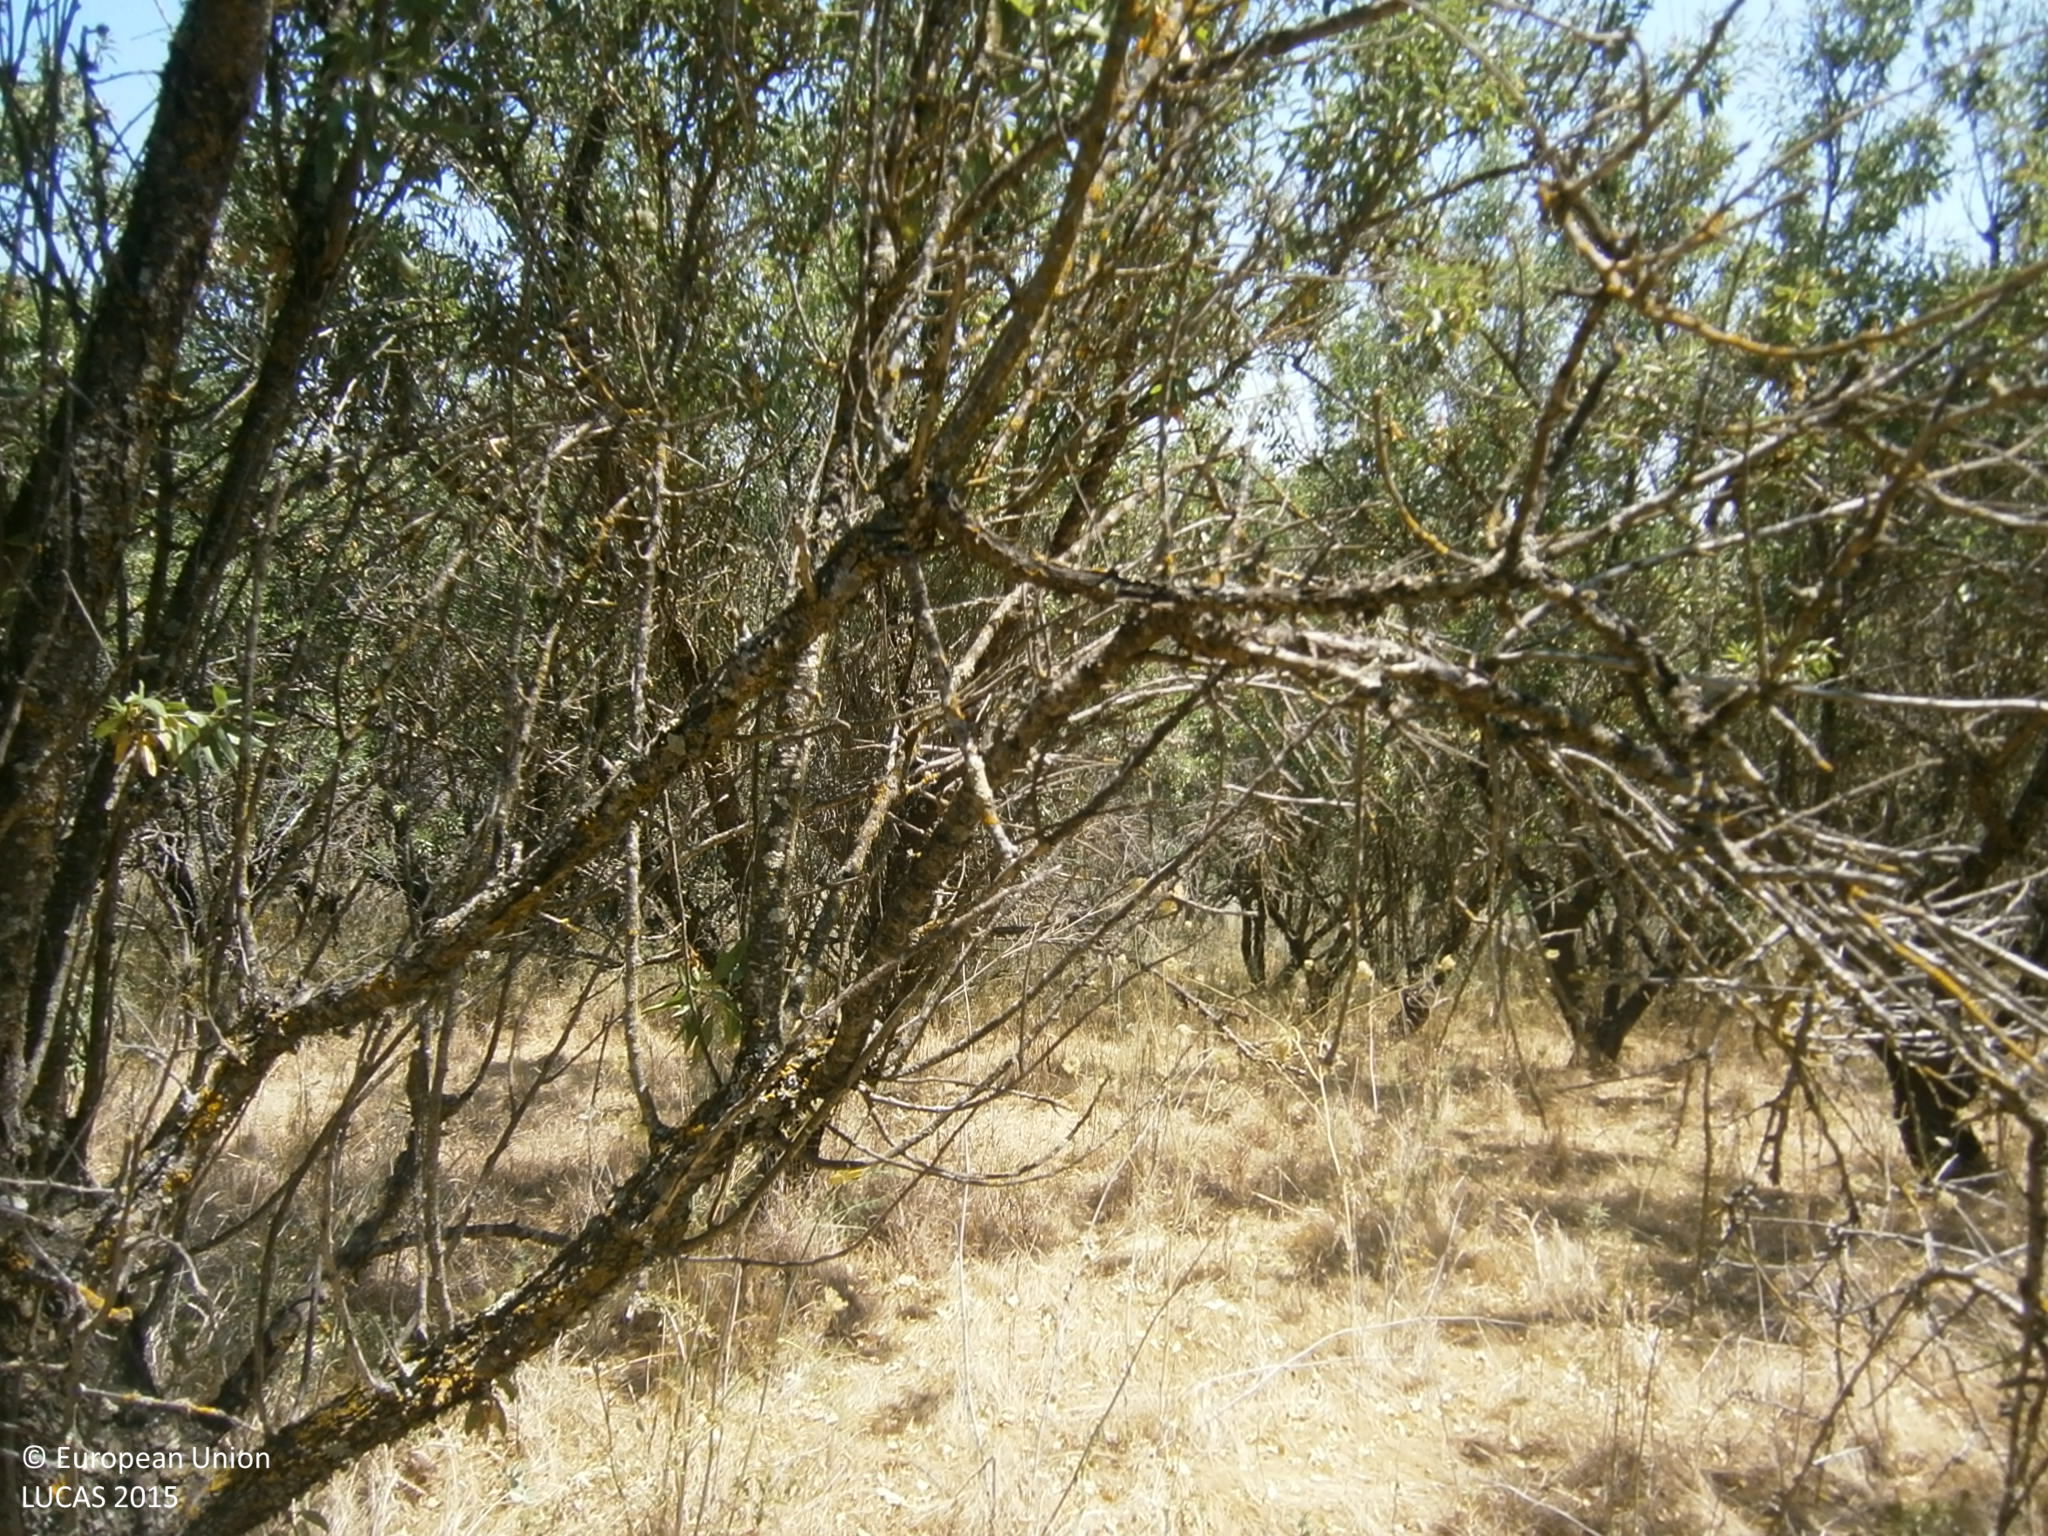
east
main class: Cropland
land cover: Nuts trees
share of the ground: > 75 %
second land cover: Spontaneously vegetated surfaces
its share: 25 - 50 %
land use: Agriculture (excluding fallow land and kitchen gardens)
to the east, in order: Nuts trees; Spontaneously vegetated surfaces; Grassland with sparse tree/shrub cover; Ditches and canals; Grassland with sparse tree/shrub cover; Tracks; Tomatoes
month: June
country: ES
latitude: 38.8312
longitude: -6.6619
